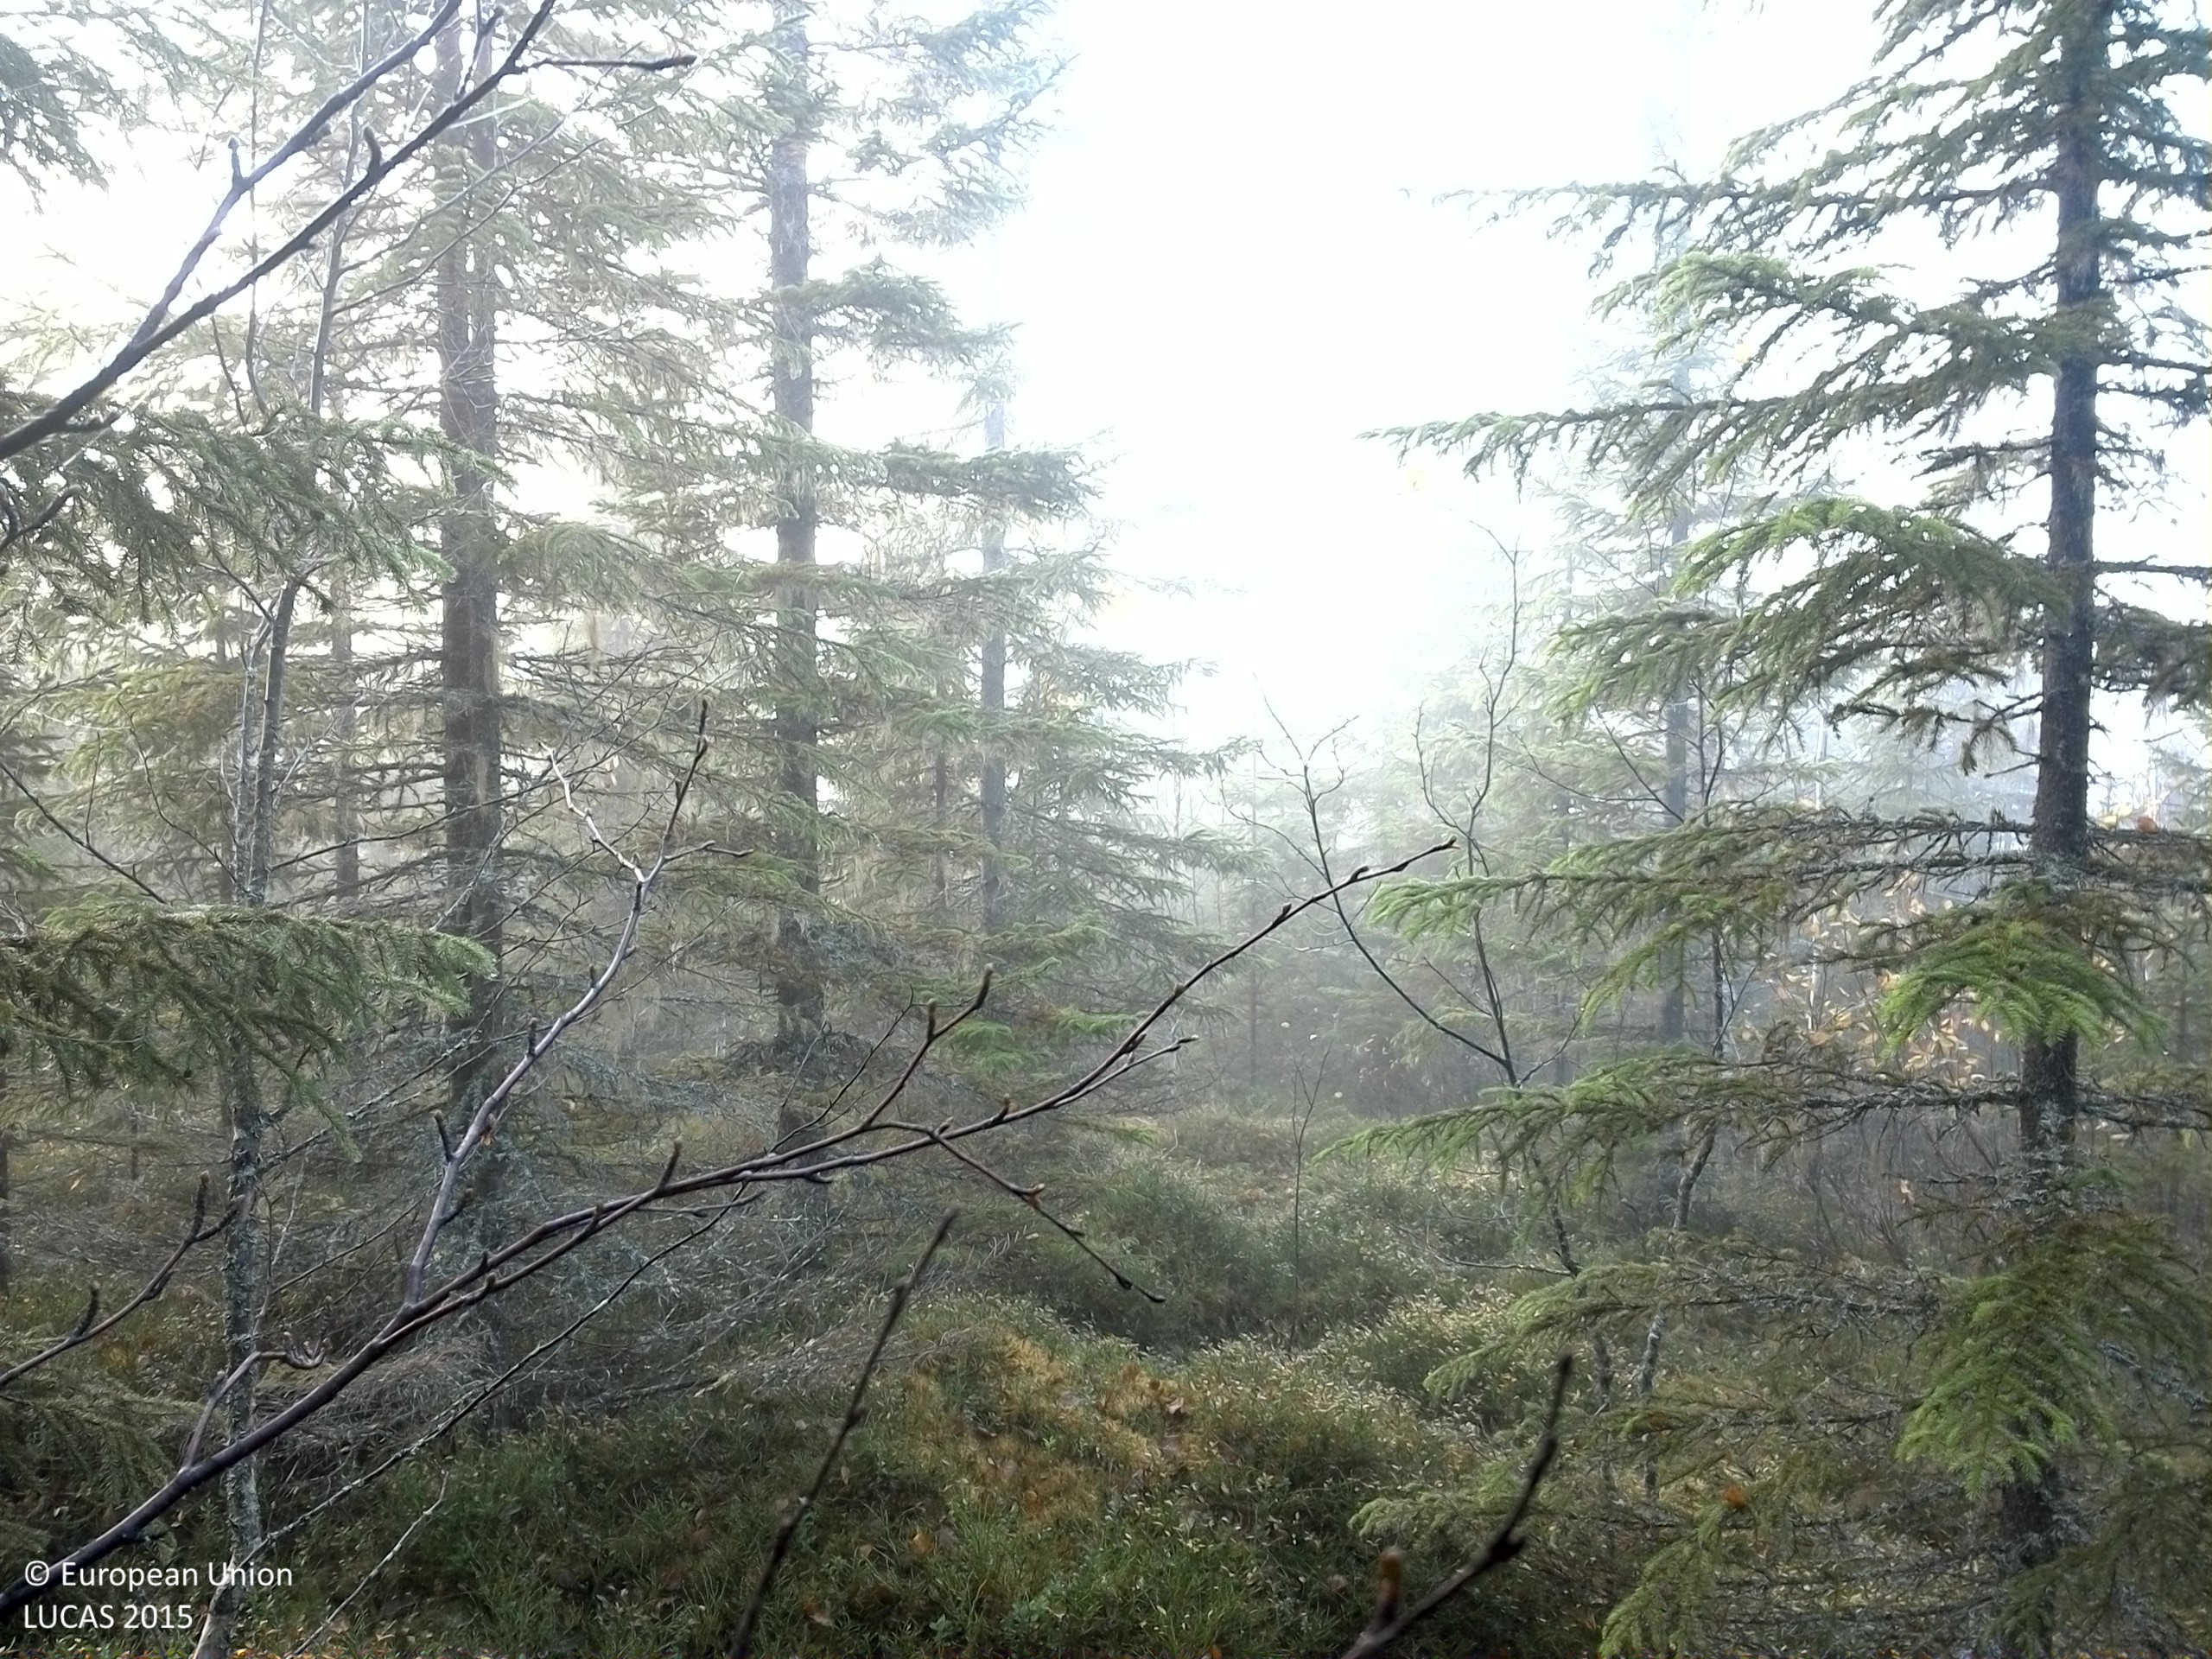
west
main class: Woodland
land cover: Spruce dominated coniferous woodland
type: boreal forest
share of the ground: 50 - 75 %
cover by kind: coniferous forest trees 50 %, shrubs 25 %, broadleaved forest trees 15 %, lichens and mosses 10 %
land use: Forestry
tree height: > 5 m
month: October
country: SE
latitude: 64.0556
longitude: 16.3011
